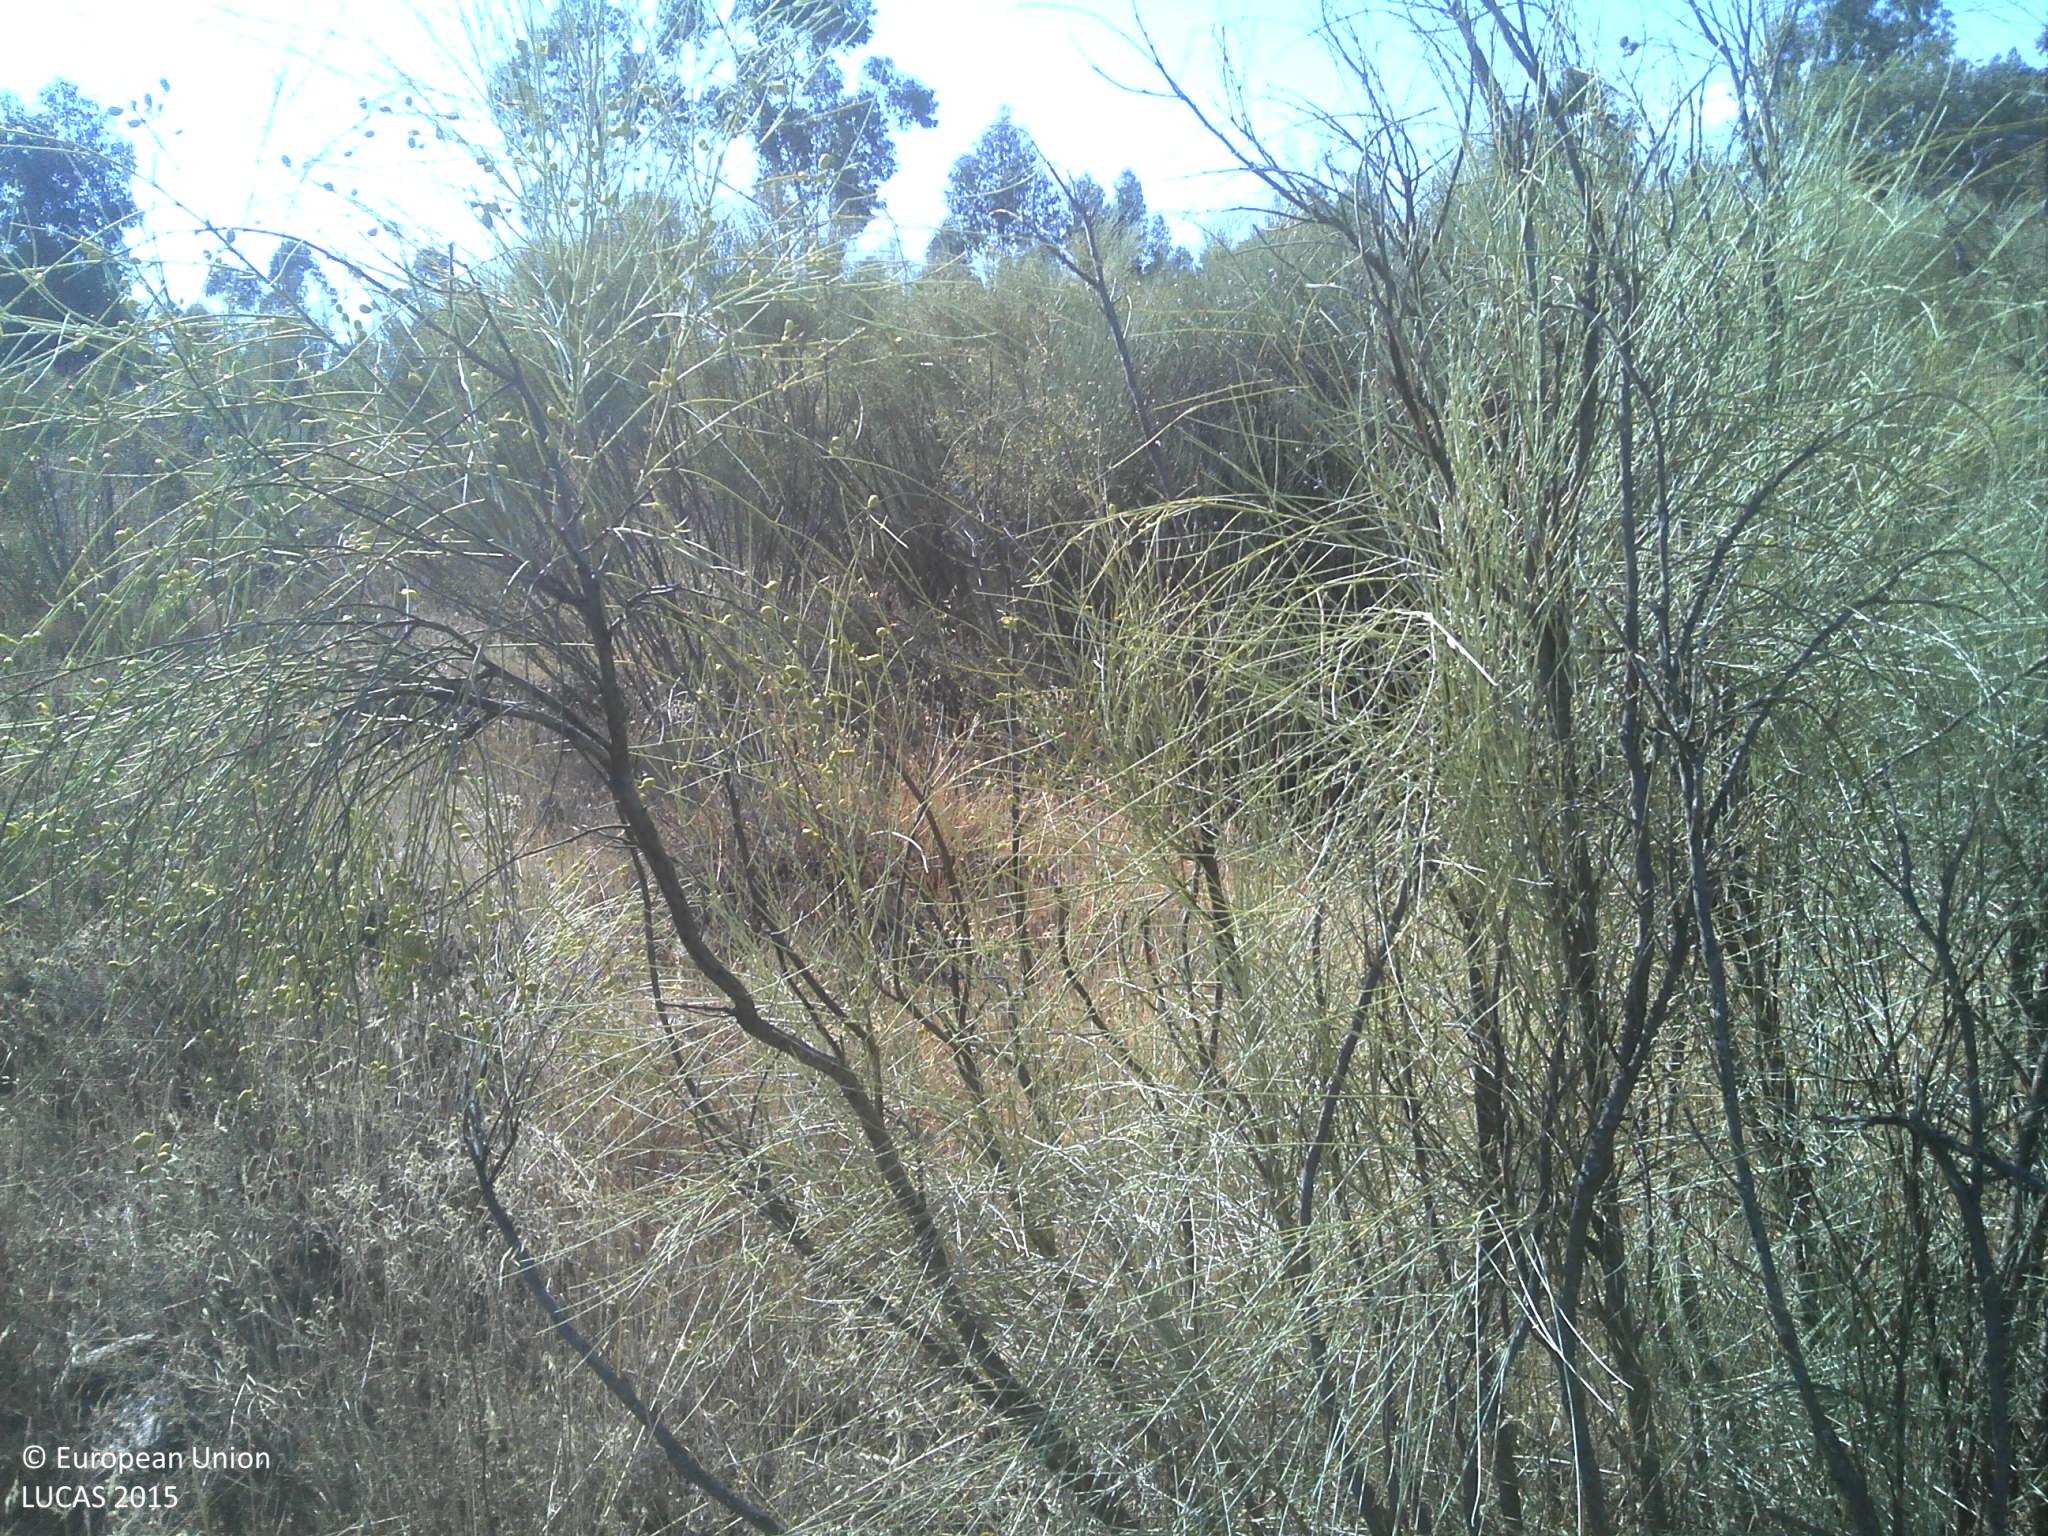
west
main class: Shrubland
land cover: Shrubland with sparse tree cover
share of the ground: 50 - 75 %
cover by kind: shrubs 50 %, herbaceous plants 25 %, unconsolidated bare surface 10 %, broadleaved forest trees 5 %
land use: Forestry
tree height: > 5 m
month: June
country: PT
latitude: 39.7940
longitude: -7.0567
